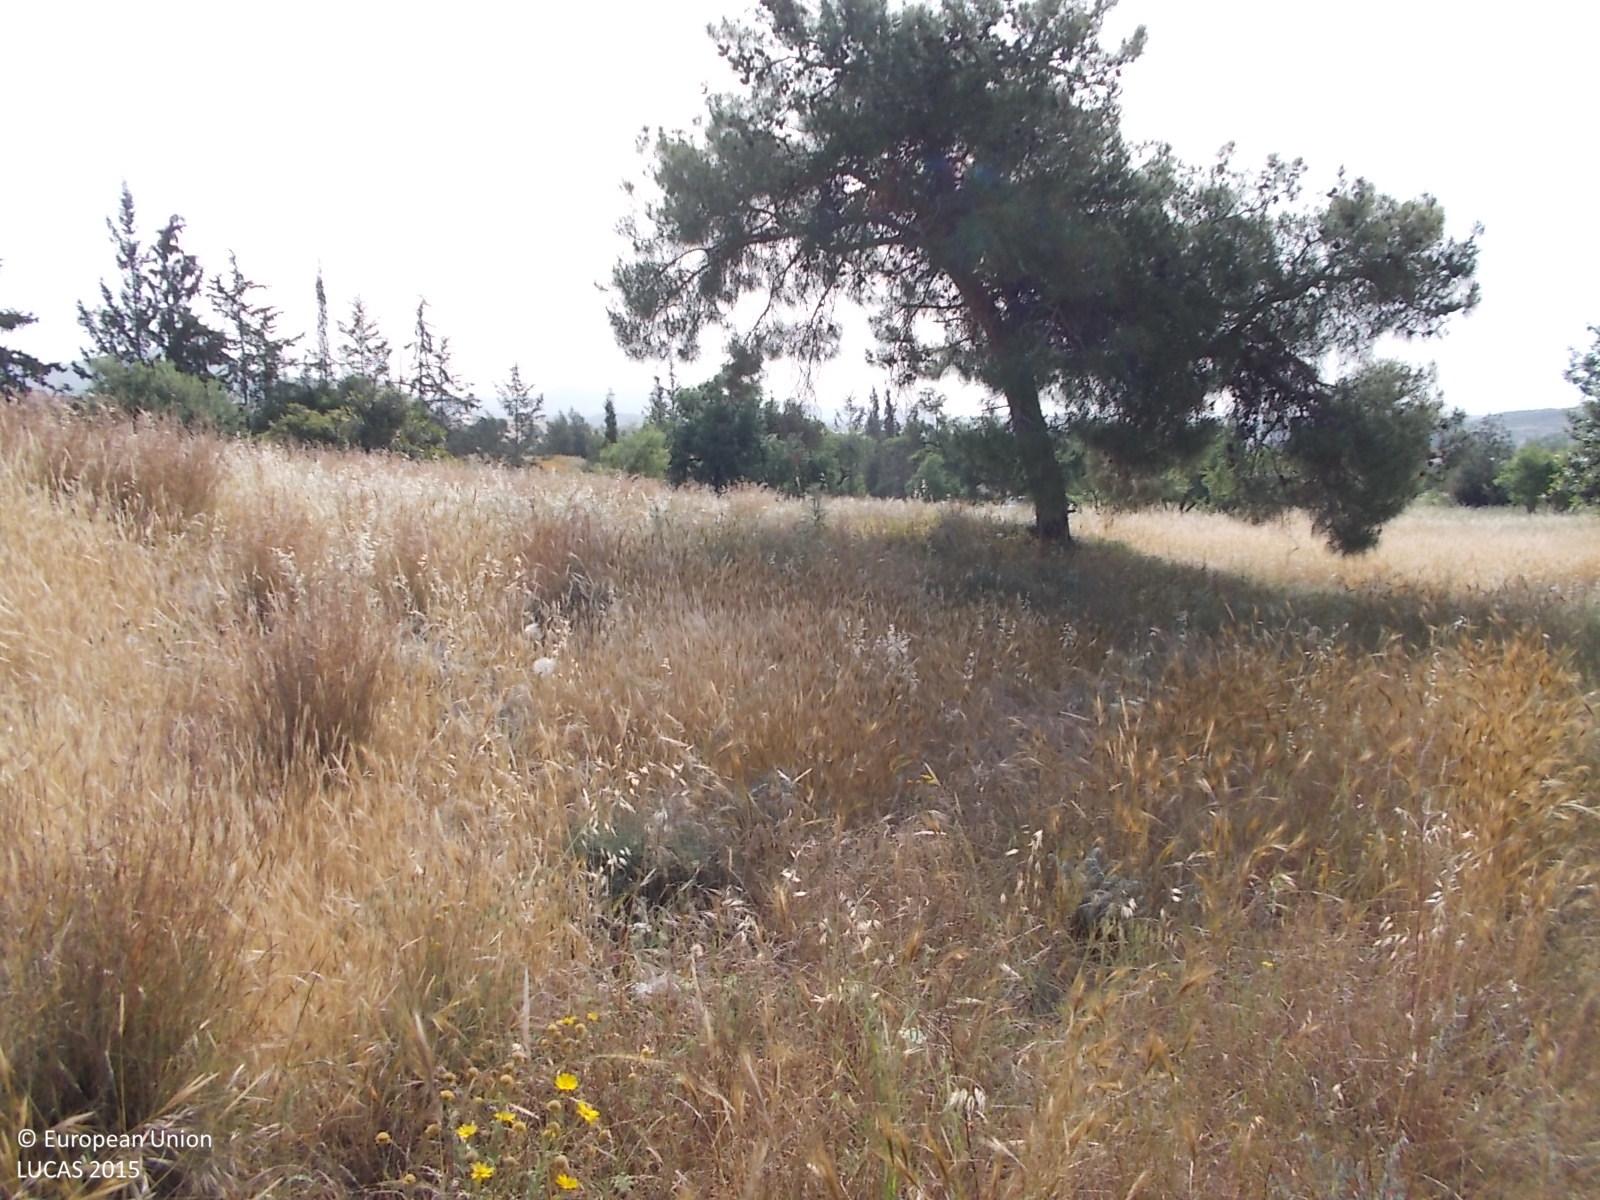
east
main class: Grassland
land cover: Spontaneously vegetated surfaces
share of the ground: > 75 %
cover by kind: herbaceous plants 100 %
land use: Fallow land
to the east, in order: Spontaneously vegetated surfaces; Nuts trees; Grass margins; Tracks; Grass margins; Fences; Lines of trees; Spontaneously vegetated surfaces; Olive groves; Spontaneously vegetated surfaces; Fences; Grass margins; Other fresh vegetables
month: April
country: CY
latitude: 34.7566
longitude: 33.1456
